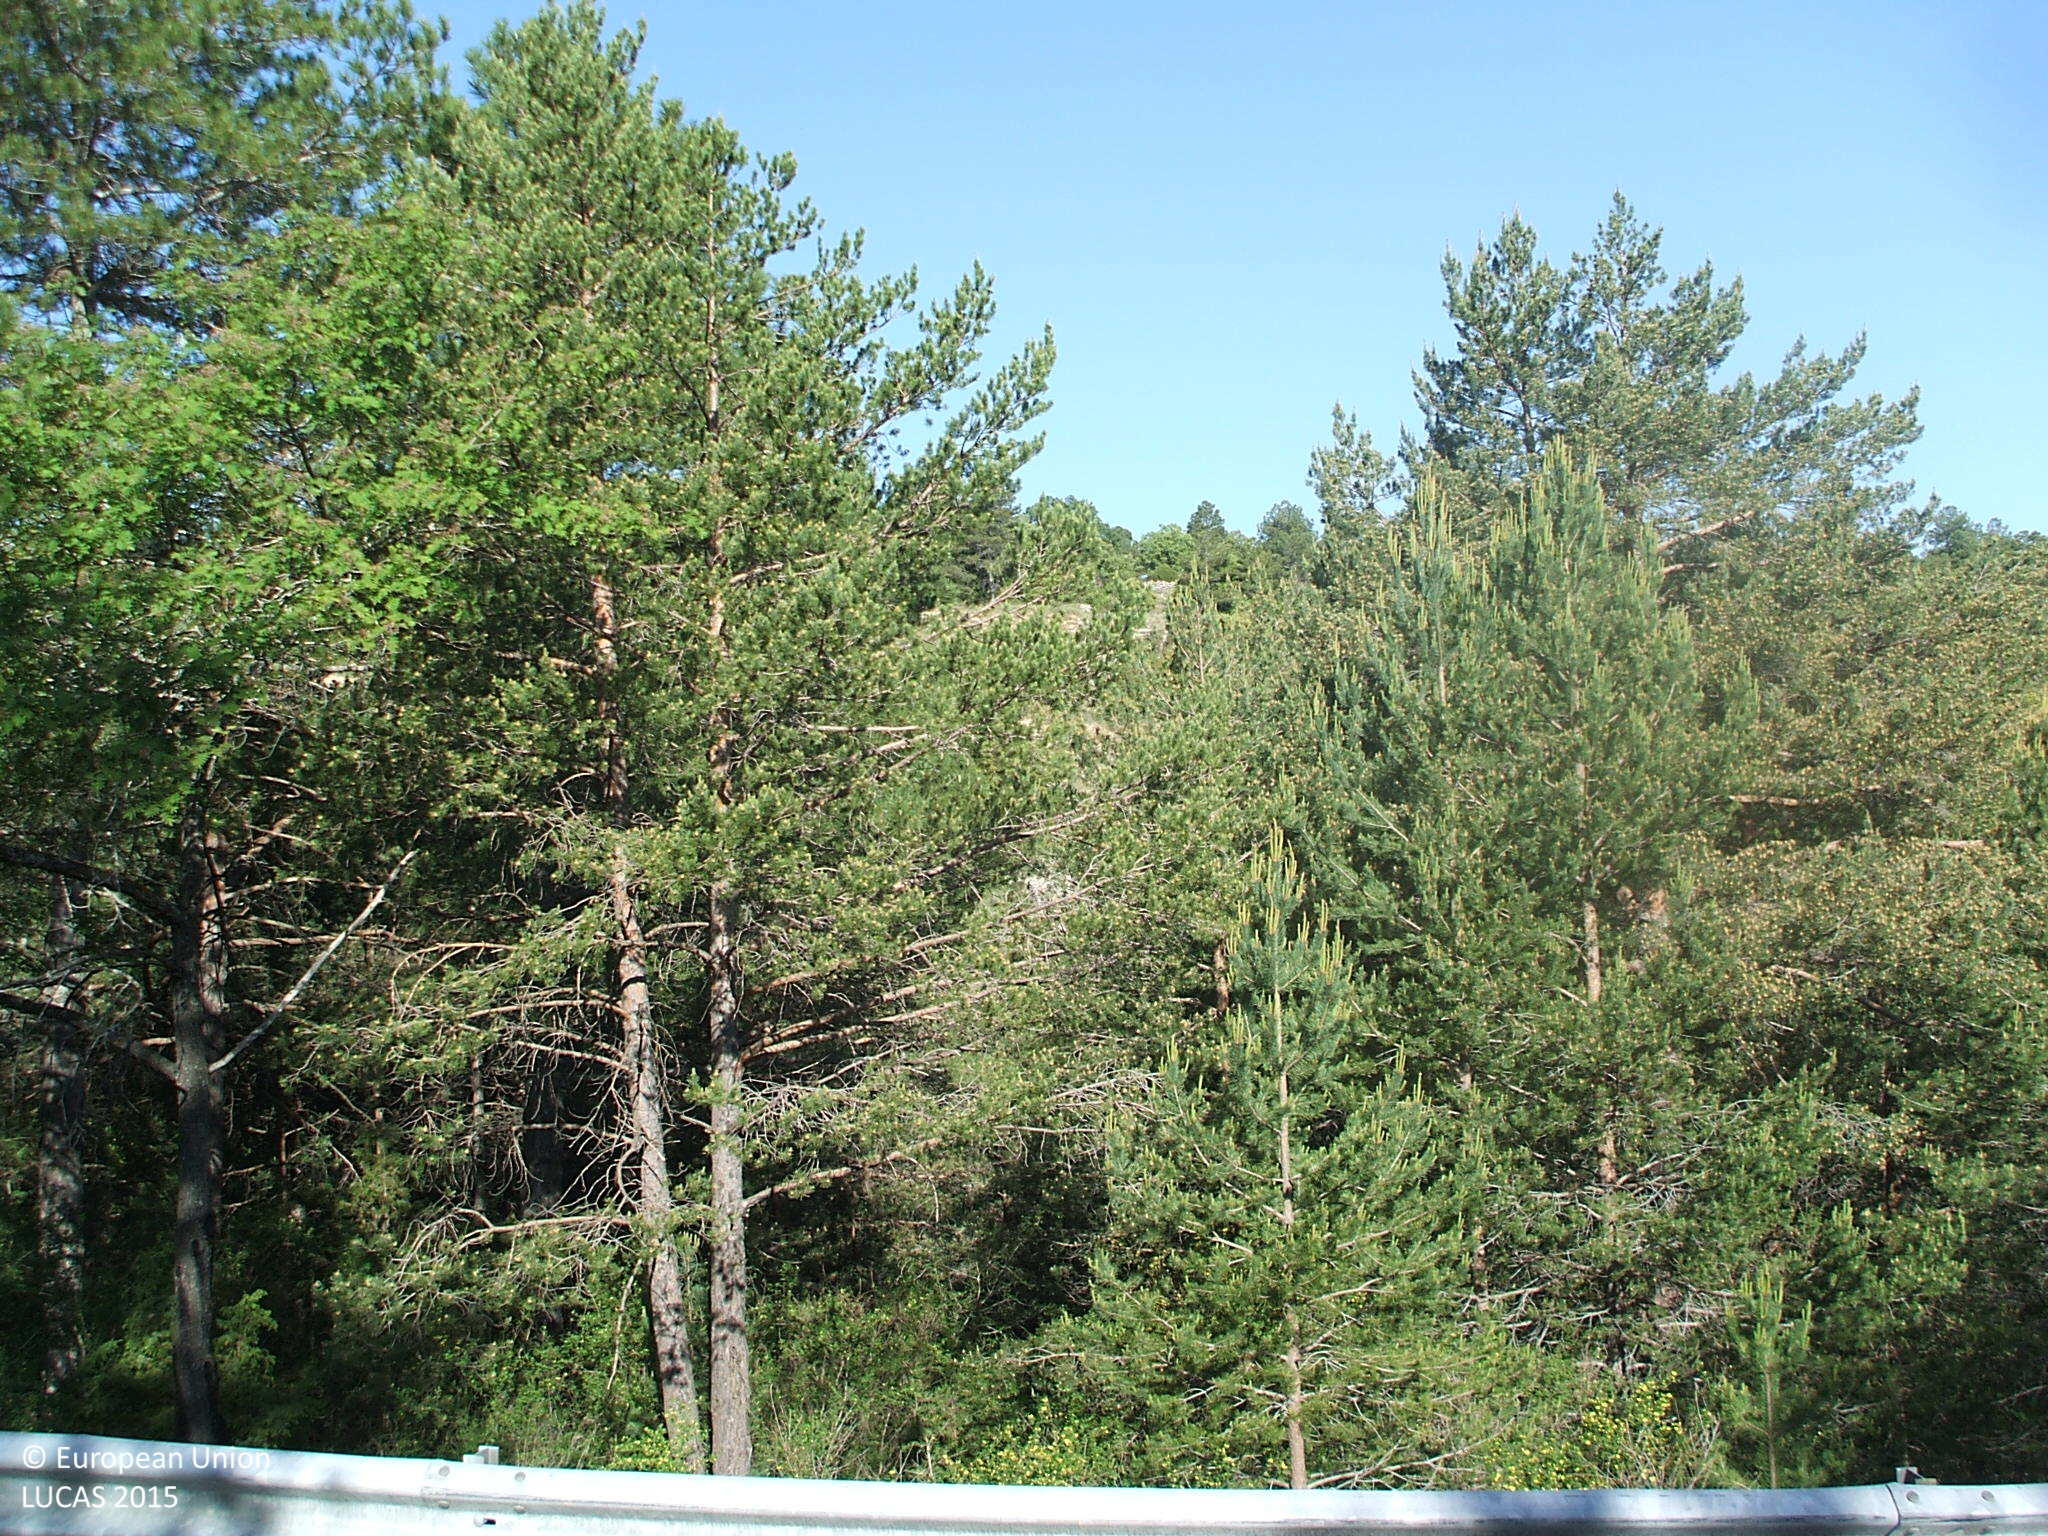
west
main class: Woodland
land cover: Pine dominated mixed woodland
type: coniferous forest of the mediterranean region
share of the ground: 50 - 75 %
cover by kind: herbaceous plants 40 %, coniferous forest trees 35 %, broadleaved forest trees 25 %
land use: Semi-natural and natural areas not in use
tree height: > 5 m
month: May
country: ES
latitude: 40.5674
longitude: -0.2482
